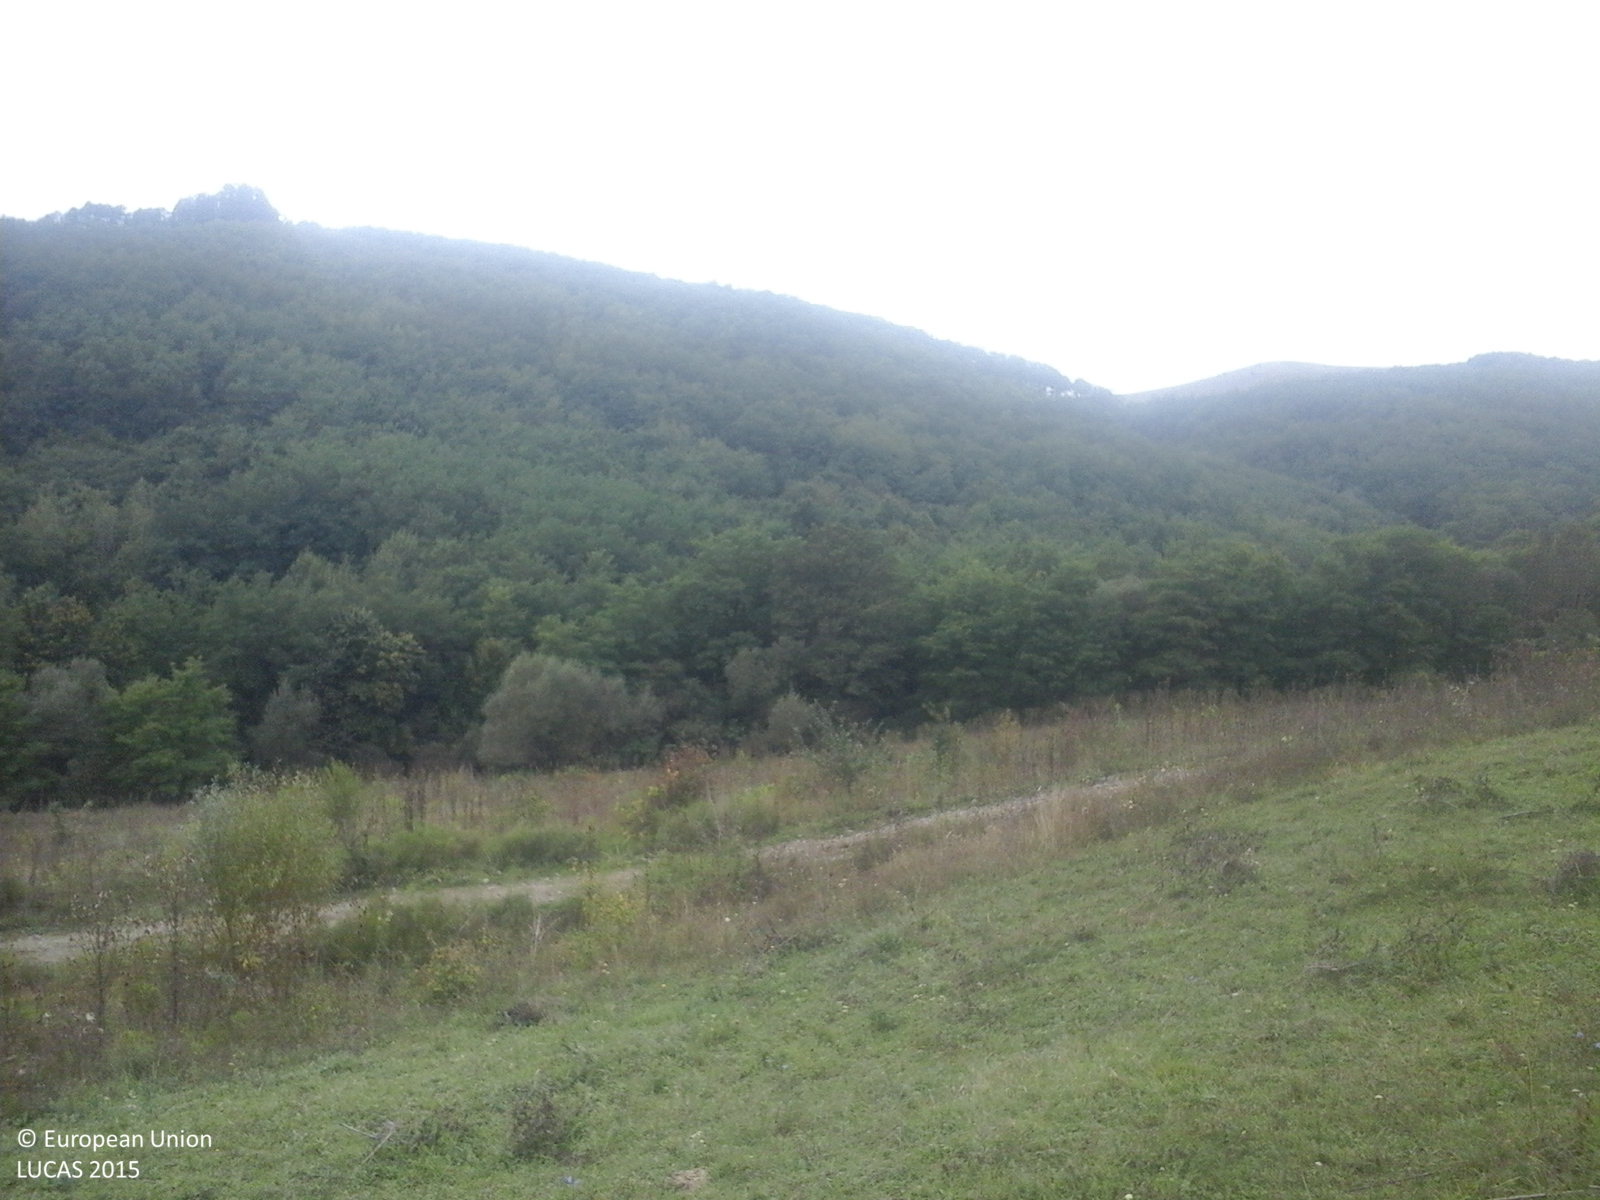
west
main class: Grassland
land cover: Grassland without tree/shrub cover
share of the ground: > 75 %
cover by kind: herbaceous plants 100 %
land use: Agriculture (excluding fallow land and kitchen gardens)
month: October
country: RO
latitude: 46.4573
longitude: 24.8721
